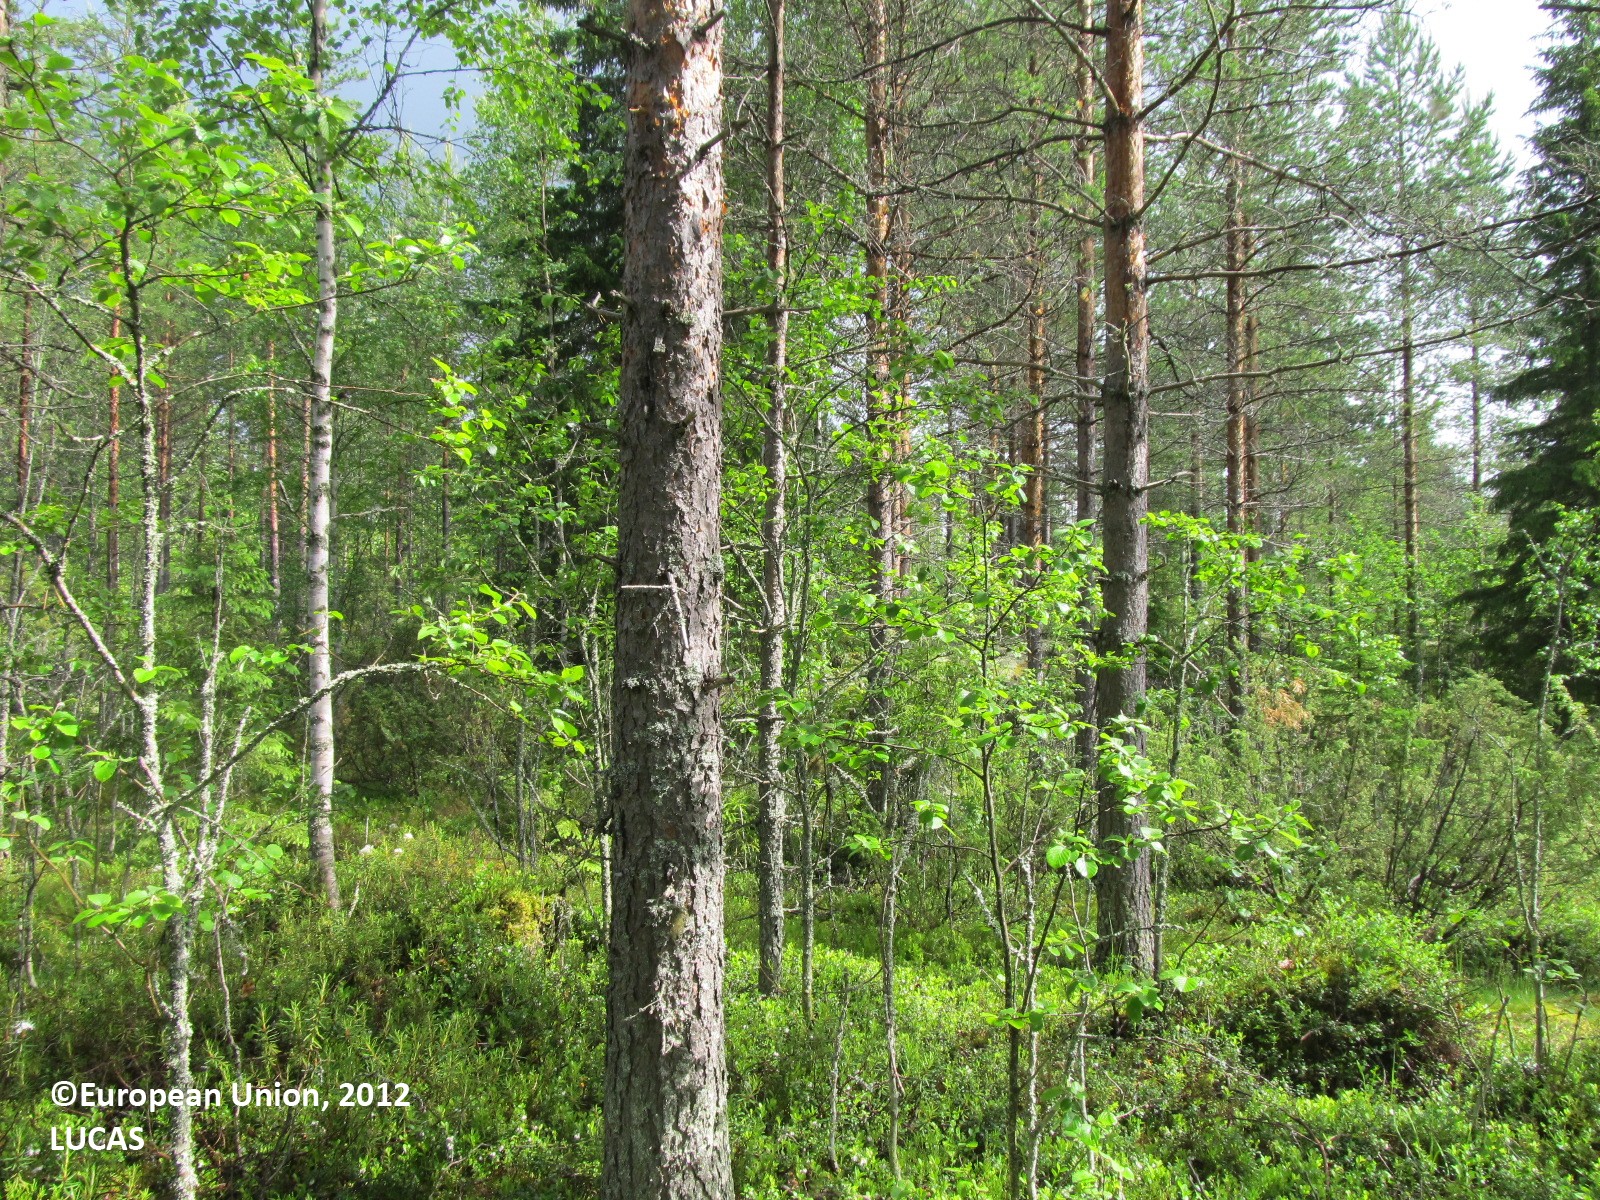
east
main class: Woodland
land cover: Pine dominated coniferous woodland
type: boreal forest
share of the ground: 25 - 50 %
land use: Forestry
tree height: > 5 m
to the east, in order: Pine dominated coniferous woodland; Pine dominated mixed woodland; Pine dominated coniferous woodland; Paved roads, cycling and walking lanes; Ditches and canals; Pine dominated mixed woodland; Inland water bodies
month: June
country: FI
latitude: 63.0321
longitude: 28.8054
